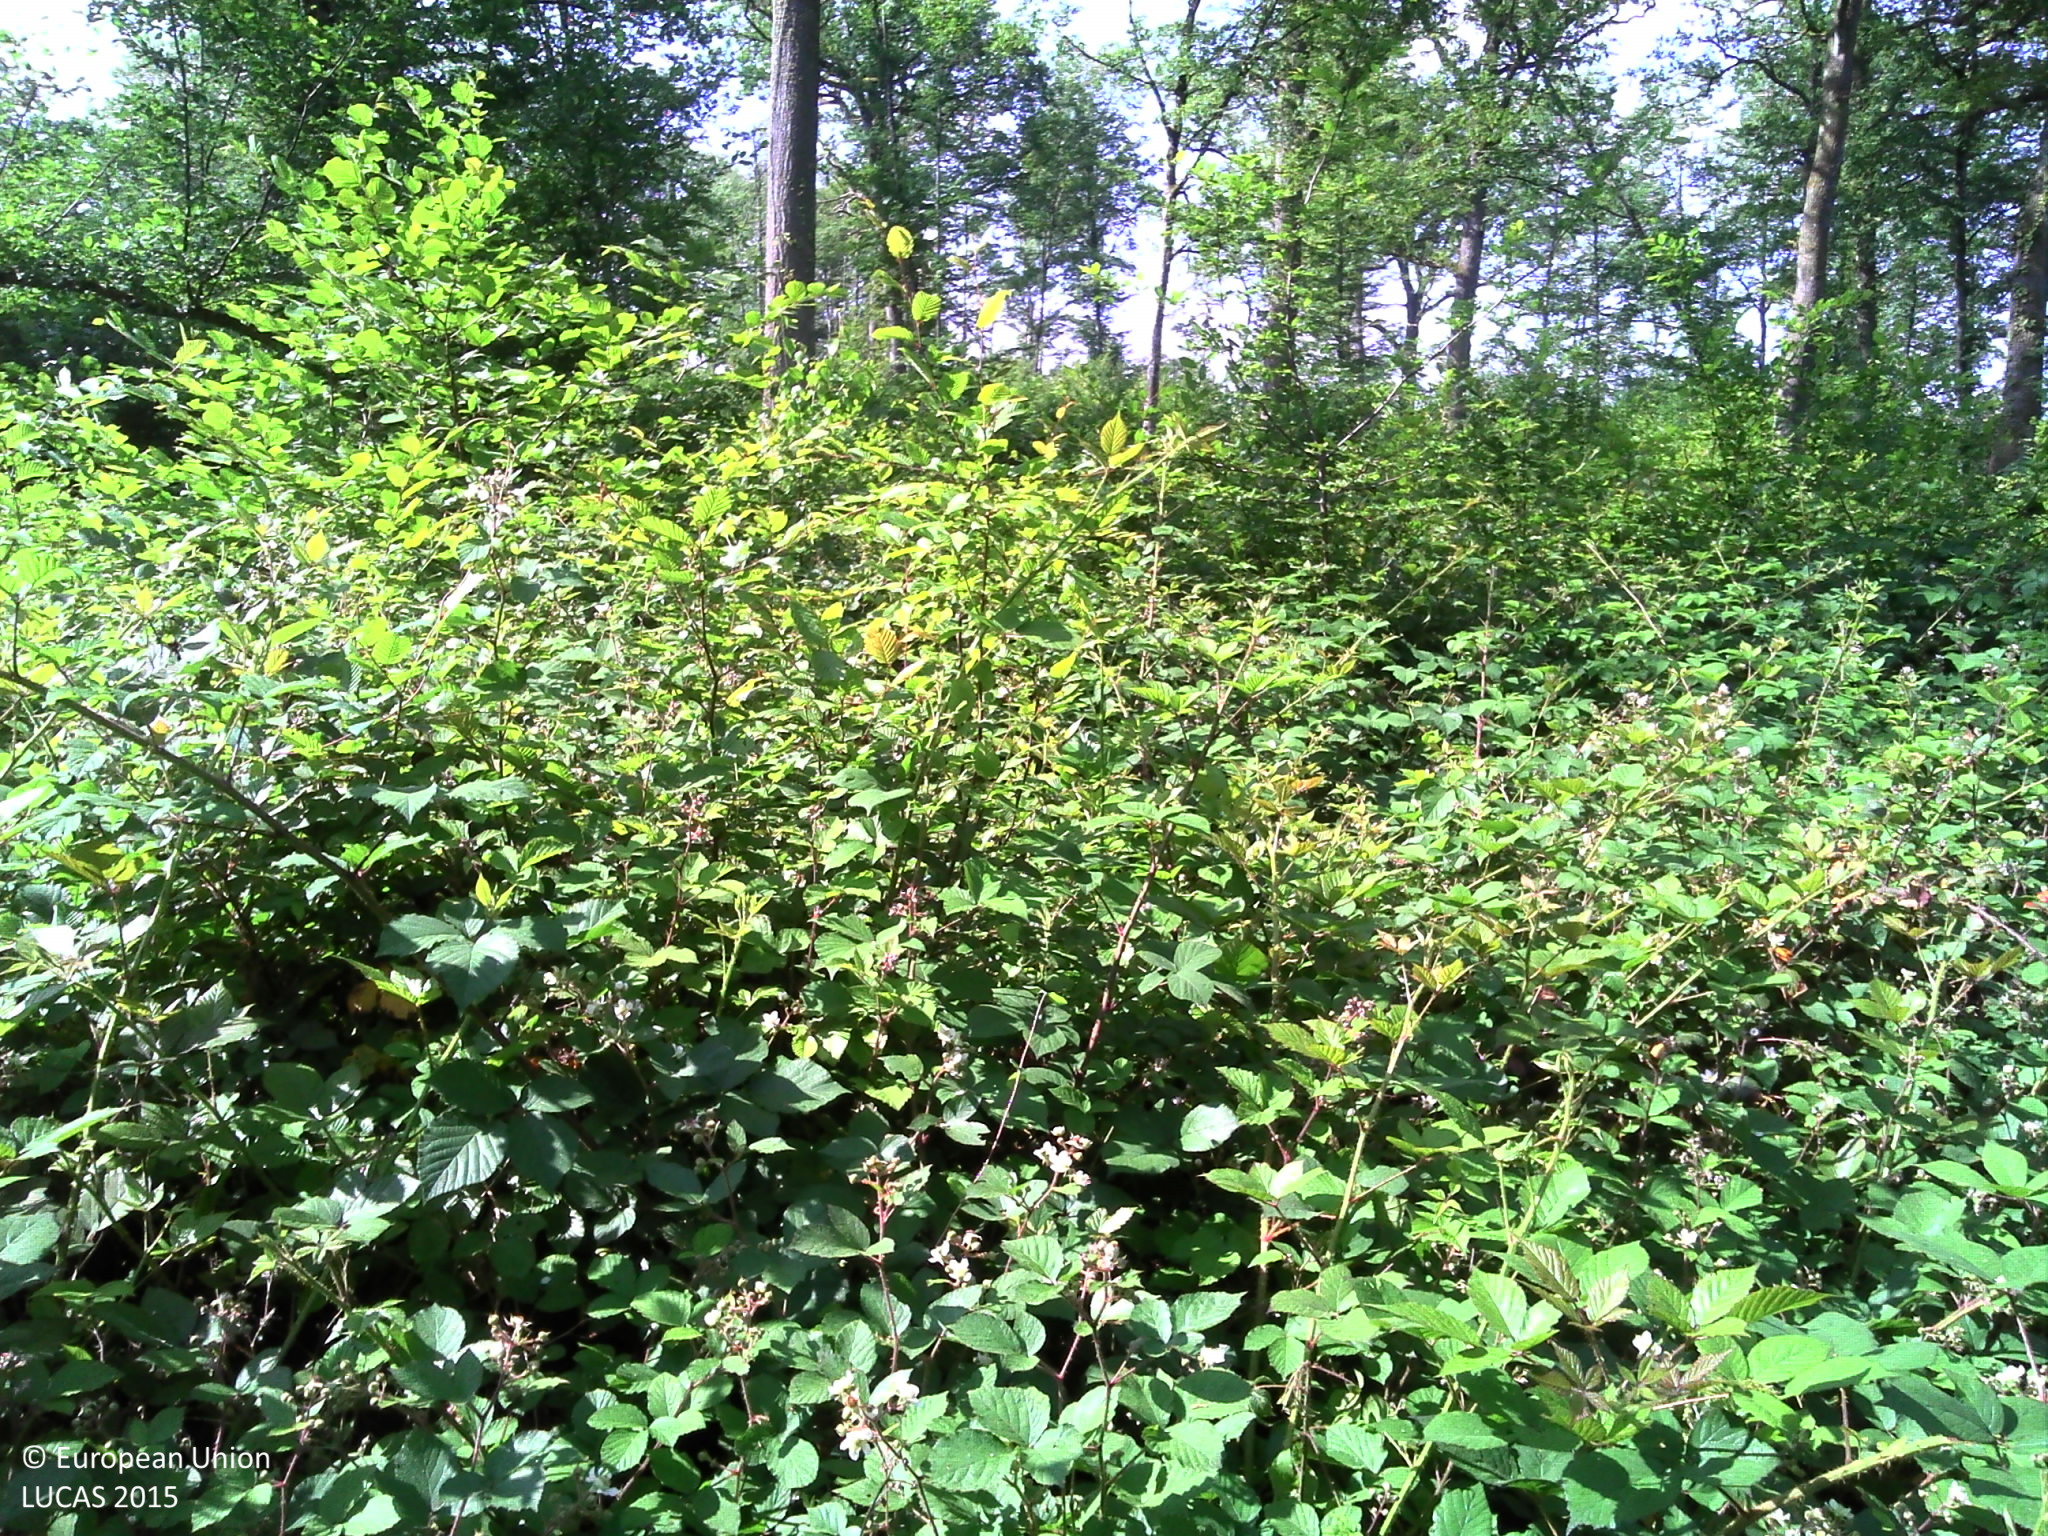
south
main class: Woodland
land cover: Broadleaved woodland
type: mesophytic deciduous forest
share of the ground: > 75 %
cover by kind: broadleaved forest trees 90 %, herbaceous plants 5 %, lichens and mosses 5 %
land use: Forestry
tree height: > 5 m
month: June
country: FR
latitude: 47.4266
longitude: 3.9660
